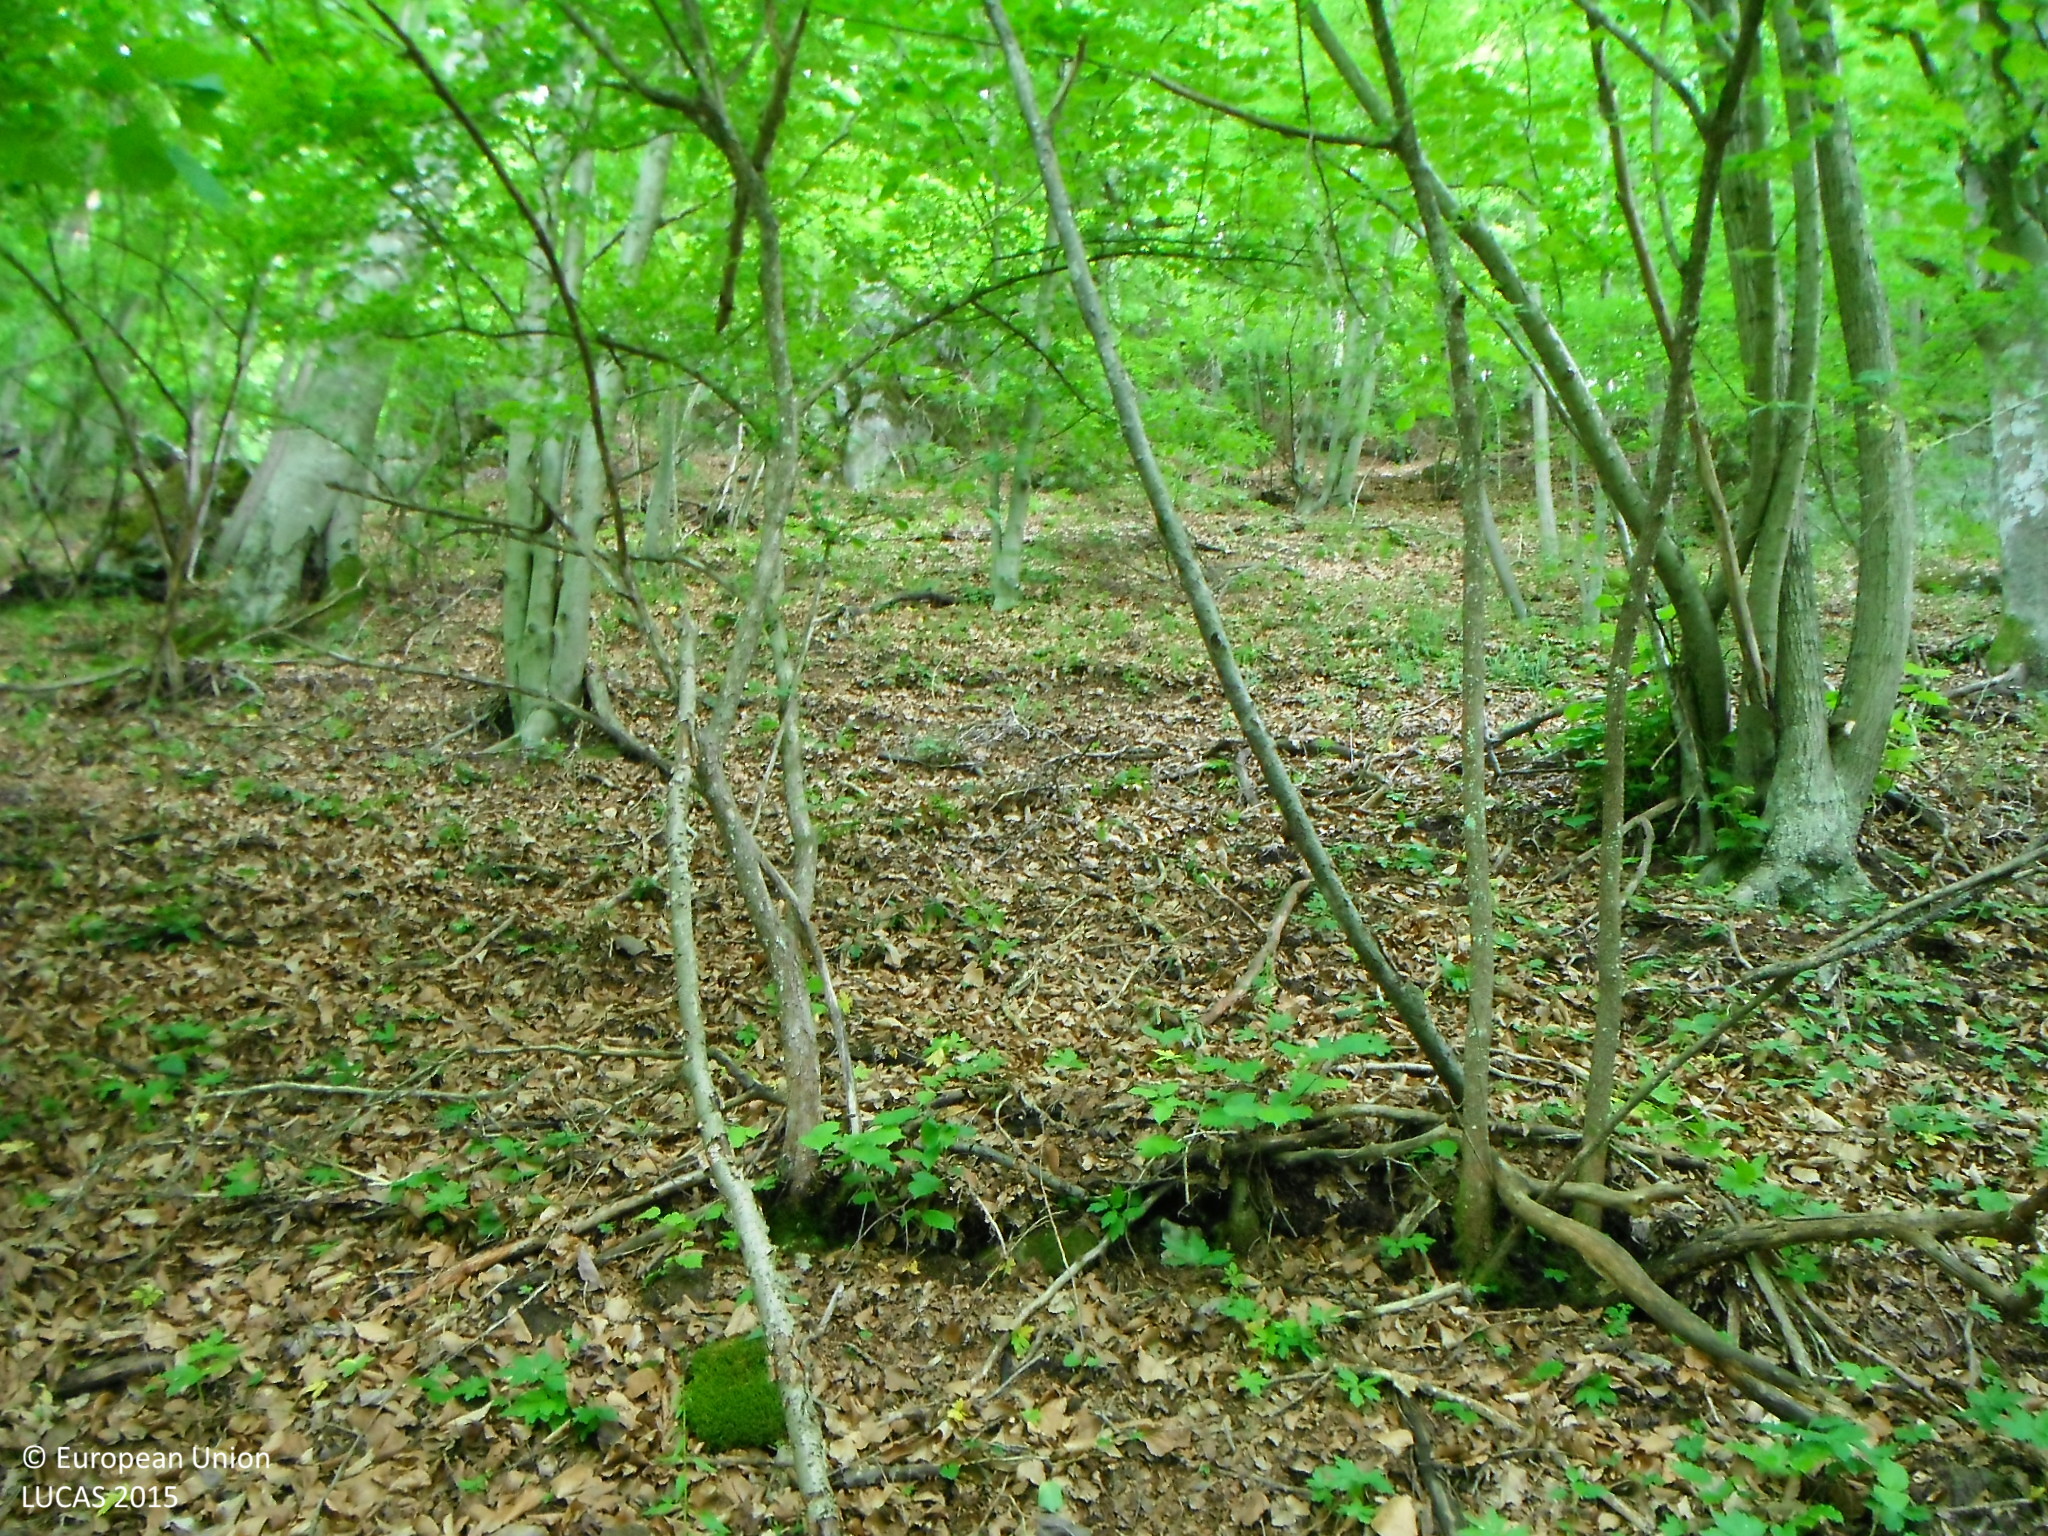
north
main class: Woodland
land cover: Broadleaved woodland
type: beech forest
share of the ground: > 75 %
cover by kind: broadleaved forest trees 100 %
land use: Forestry
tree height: > 5 m
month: June
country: SK
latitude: 48.7544
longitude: 19.2865
